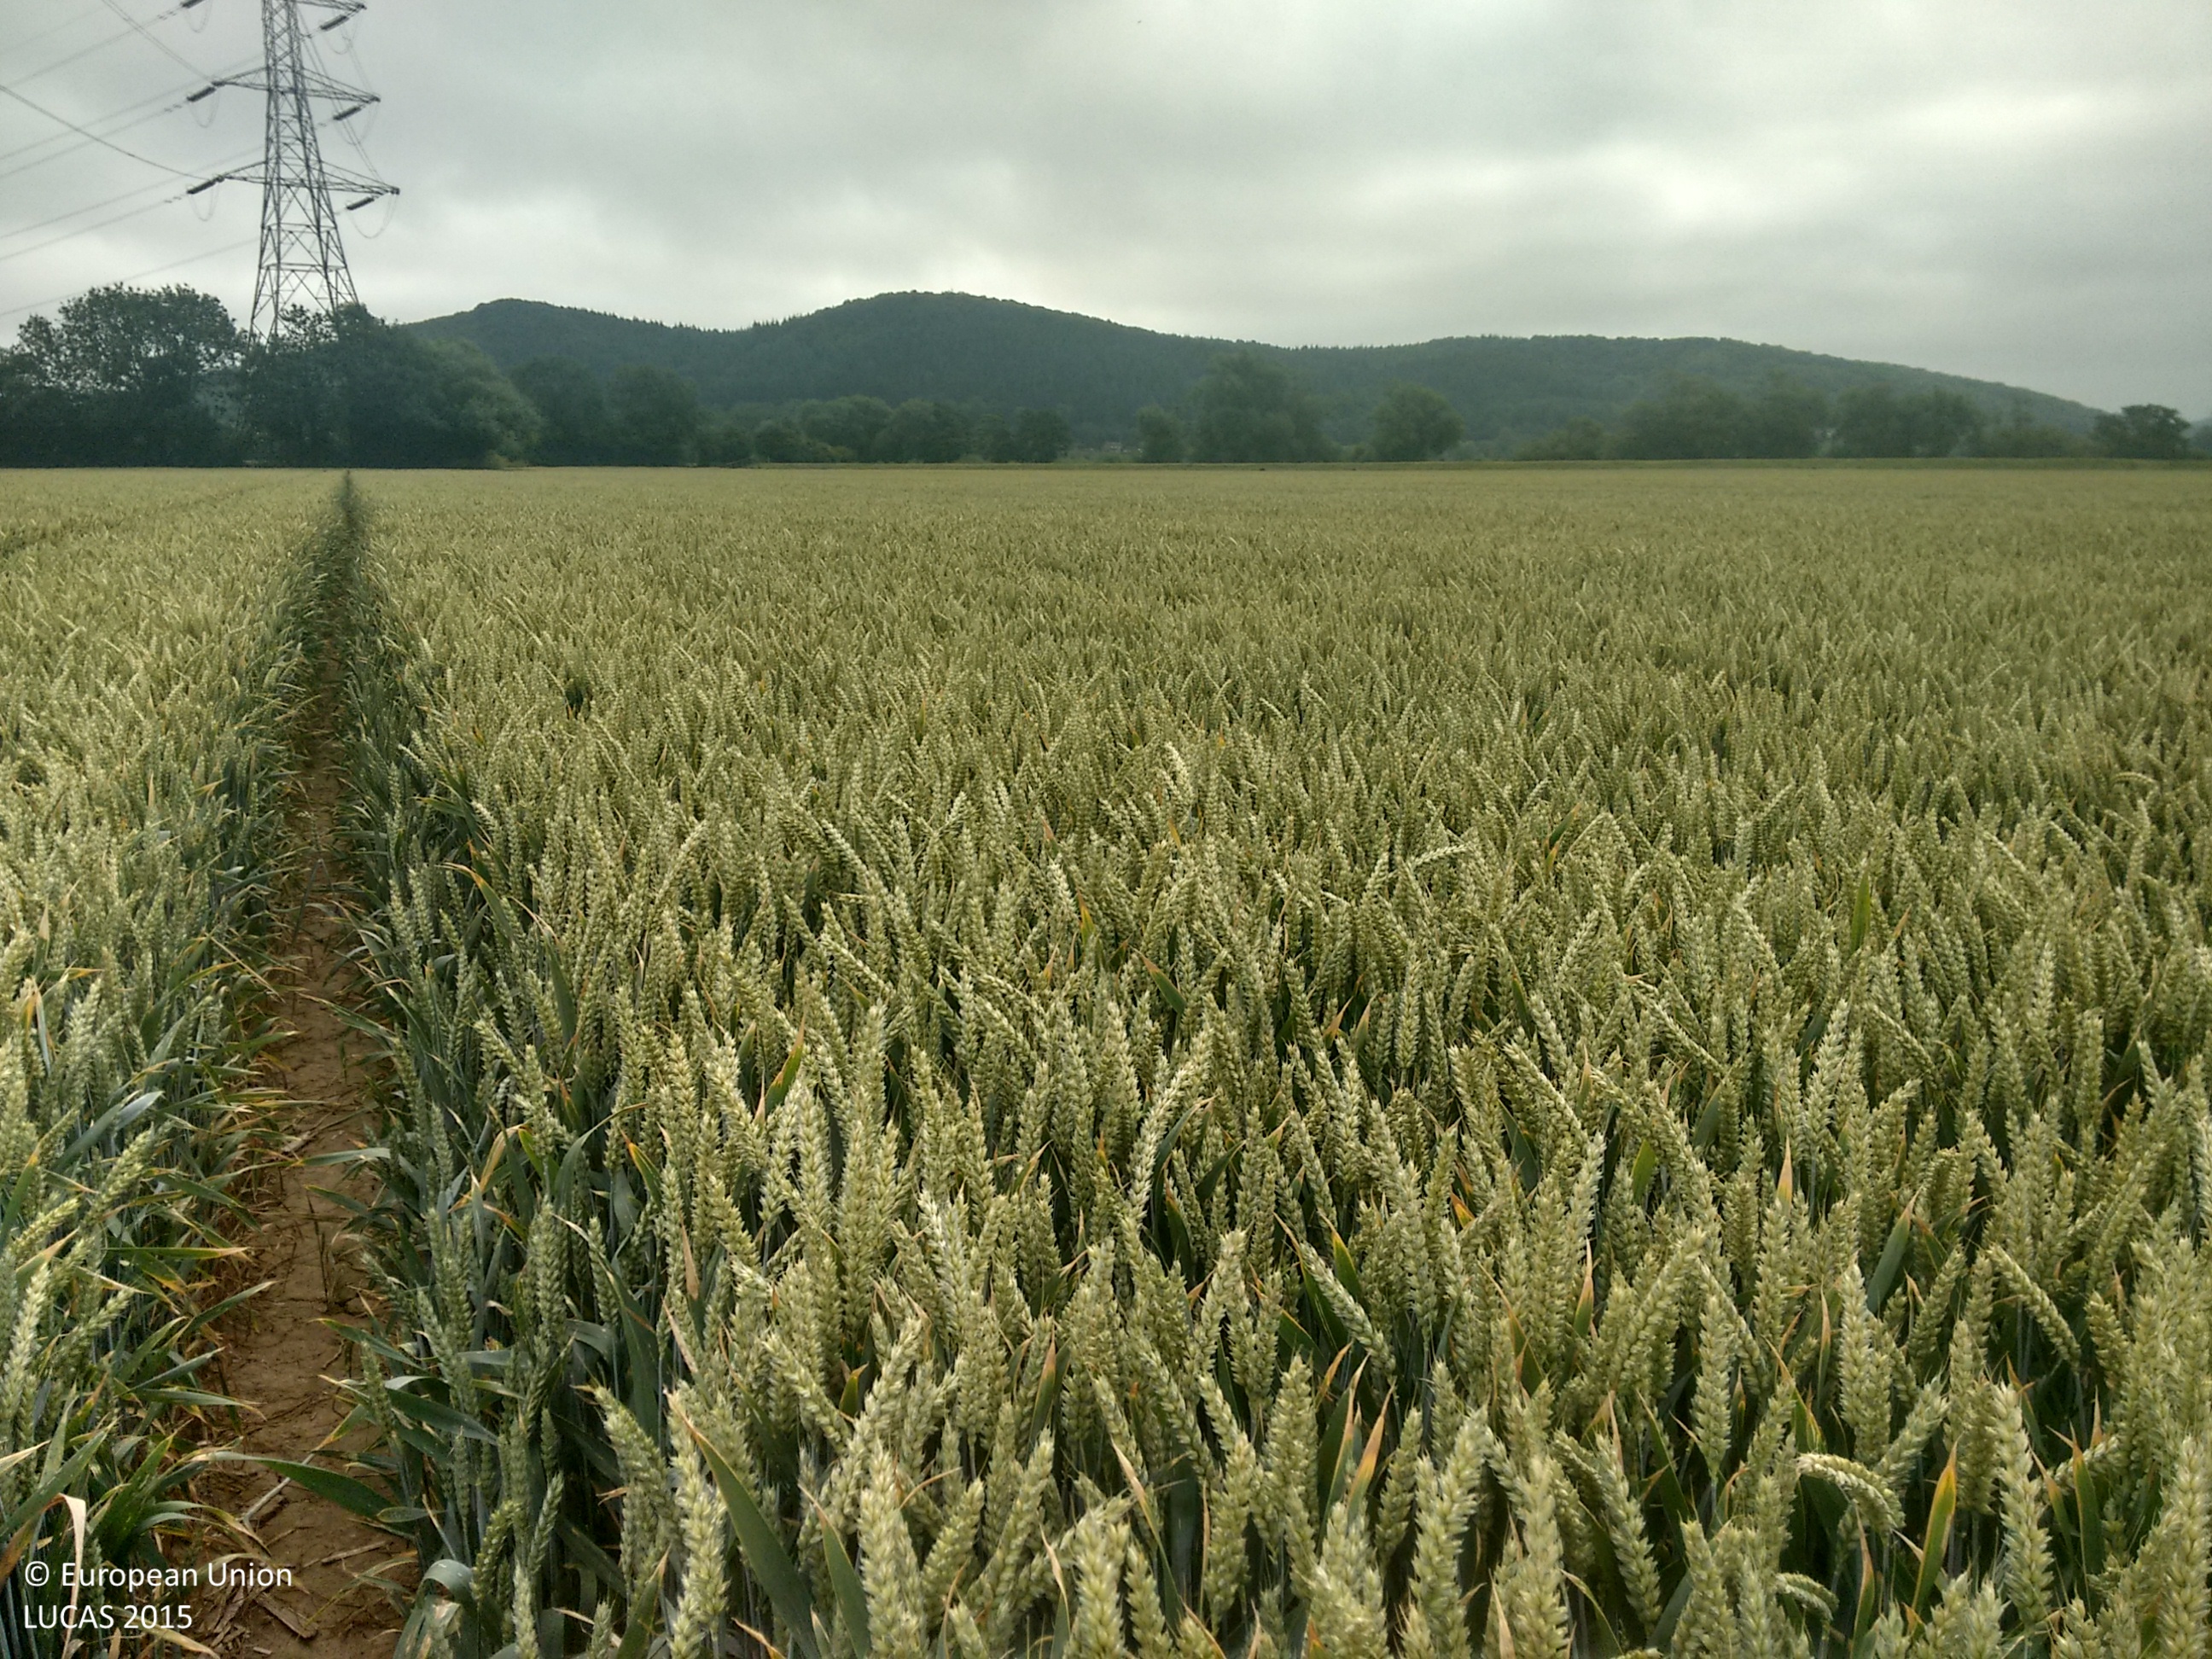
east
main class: Cropland
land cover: Common wheat
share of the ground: > 75 %
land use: Agriculture (excluding fallow land and kitchen gardens)
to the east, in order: Common wheat; Other bare soil
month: July
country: GB
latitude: 52.0254
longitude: -2.6464
